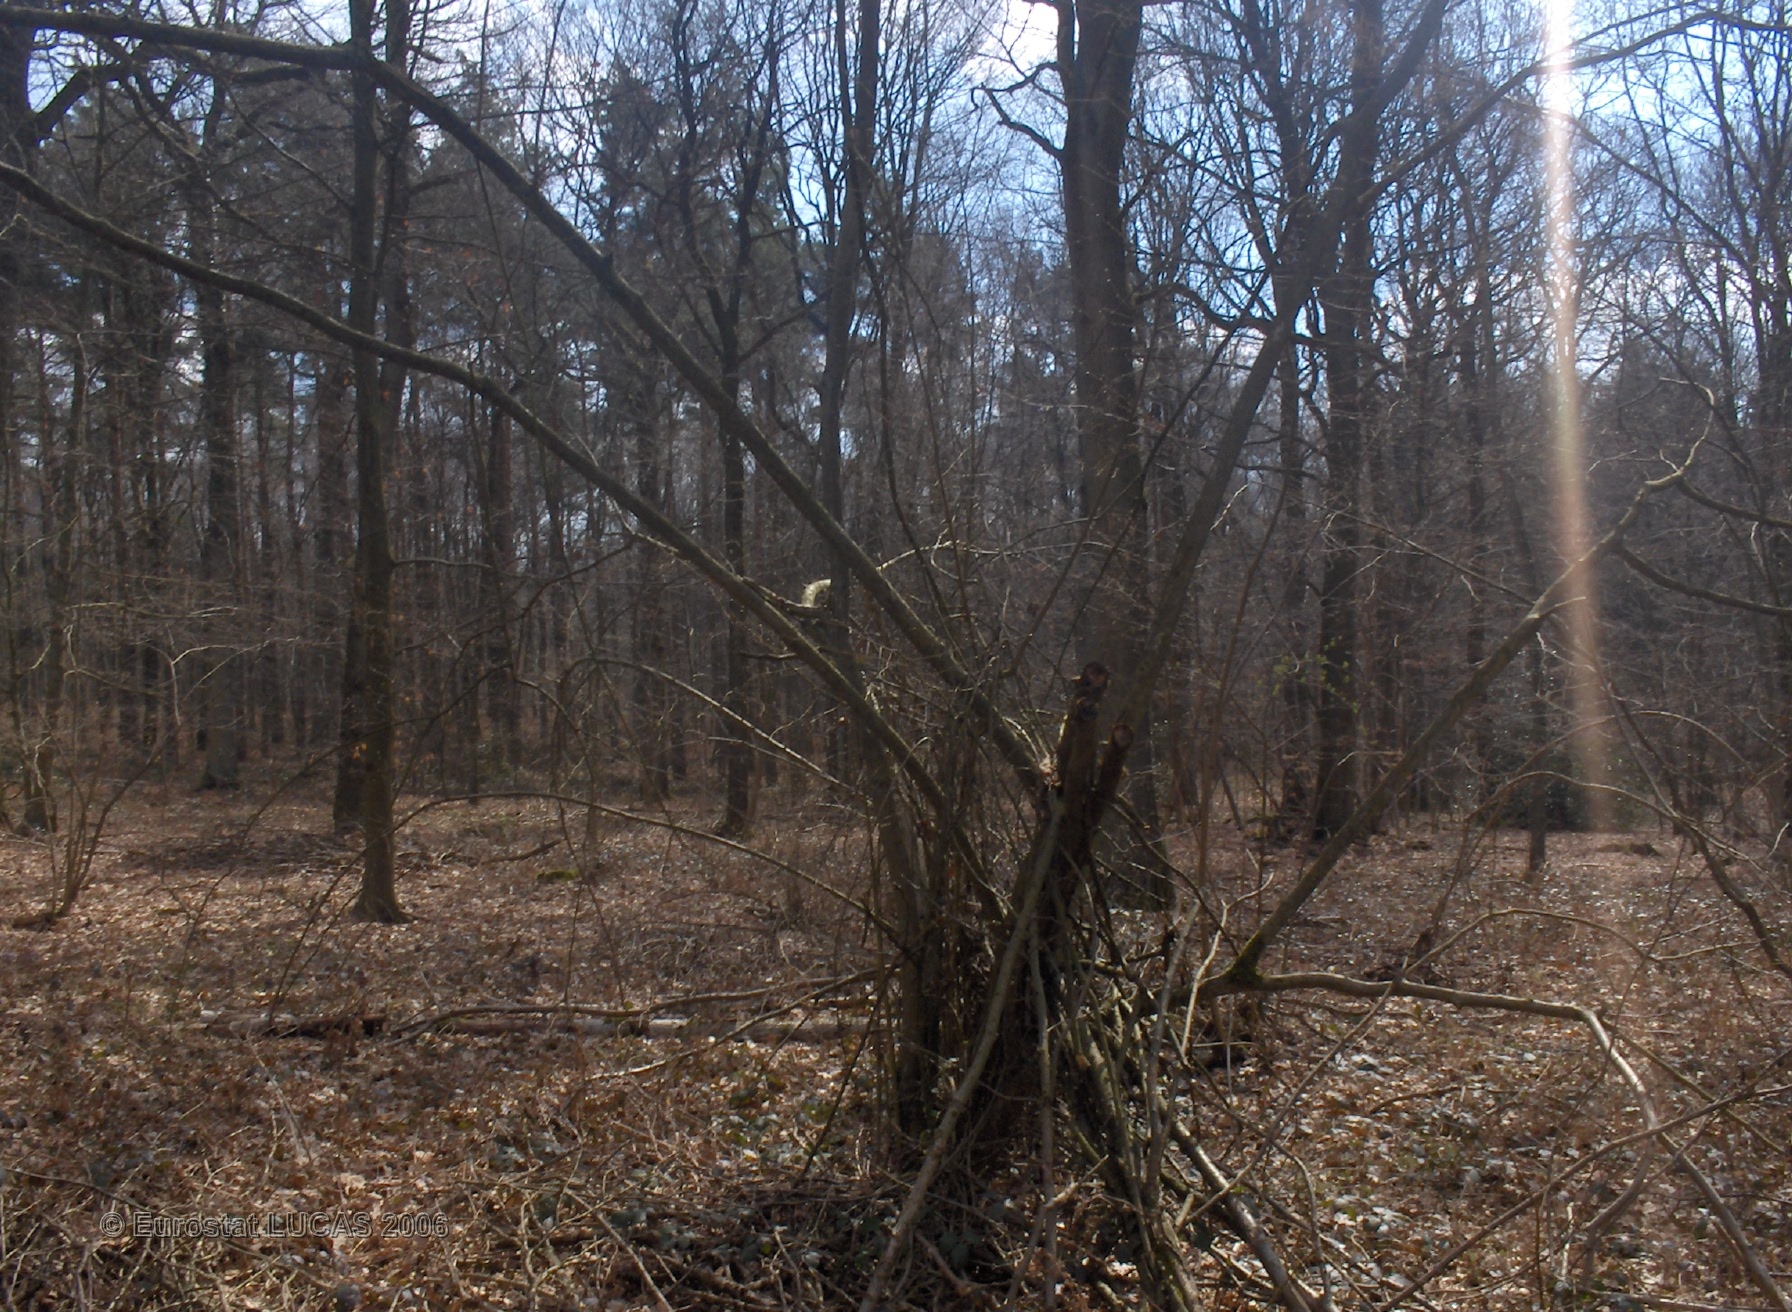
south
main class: Woodland
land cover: Mixed forest
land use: Forestry
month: April
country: BE
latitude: 50.3785
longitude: 4.5540
